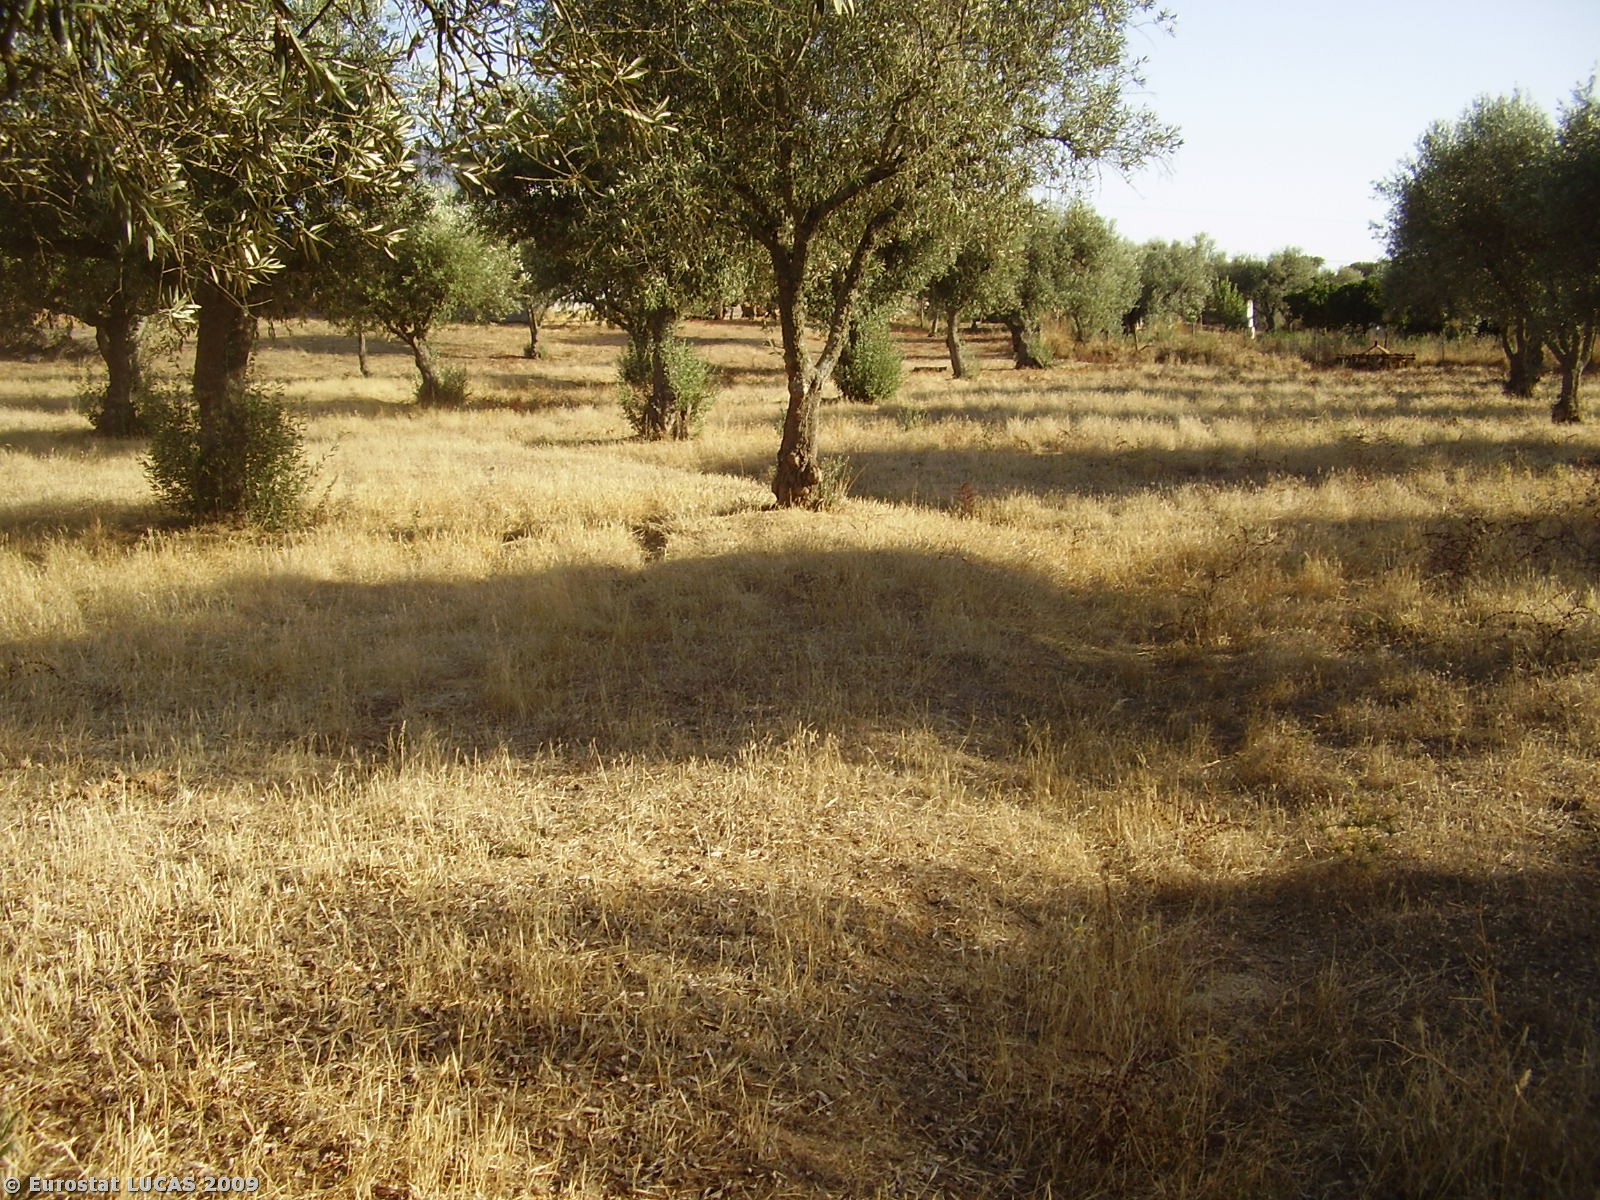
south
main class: Cropland
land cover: Olive groves
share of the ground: 25 - 50 %
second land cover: Spontaneously vegetated surfaces
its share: 50 - 75 %
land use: Agriculture (excluding fallow land and kitchen gardens)
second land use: Fallow land
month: July
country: PT
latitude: 37.7454
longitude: -7.7580
